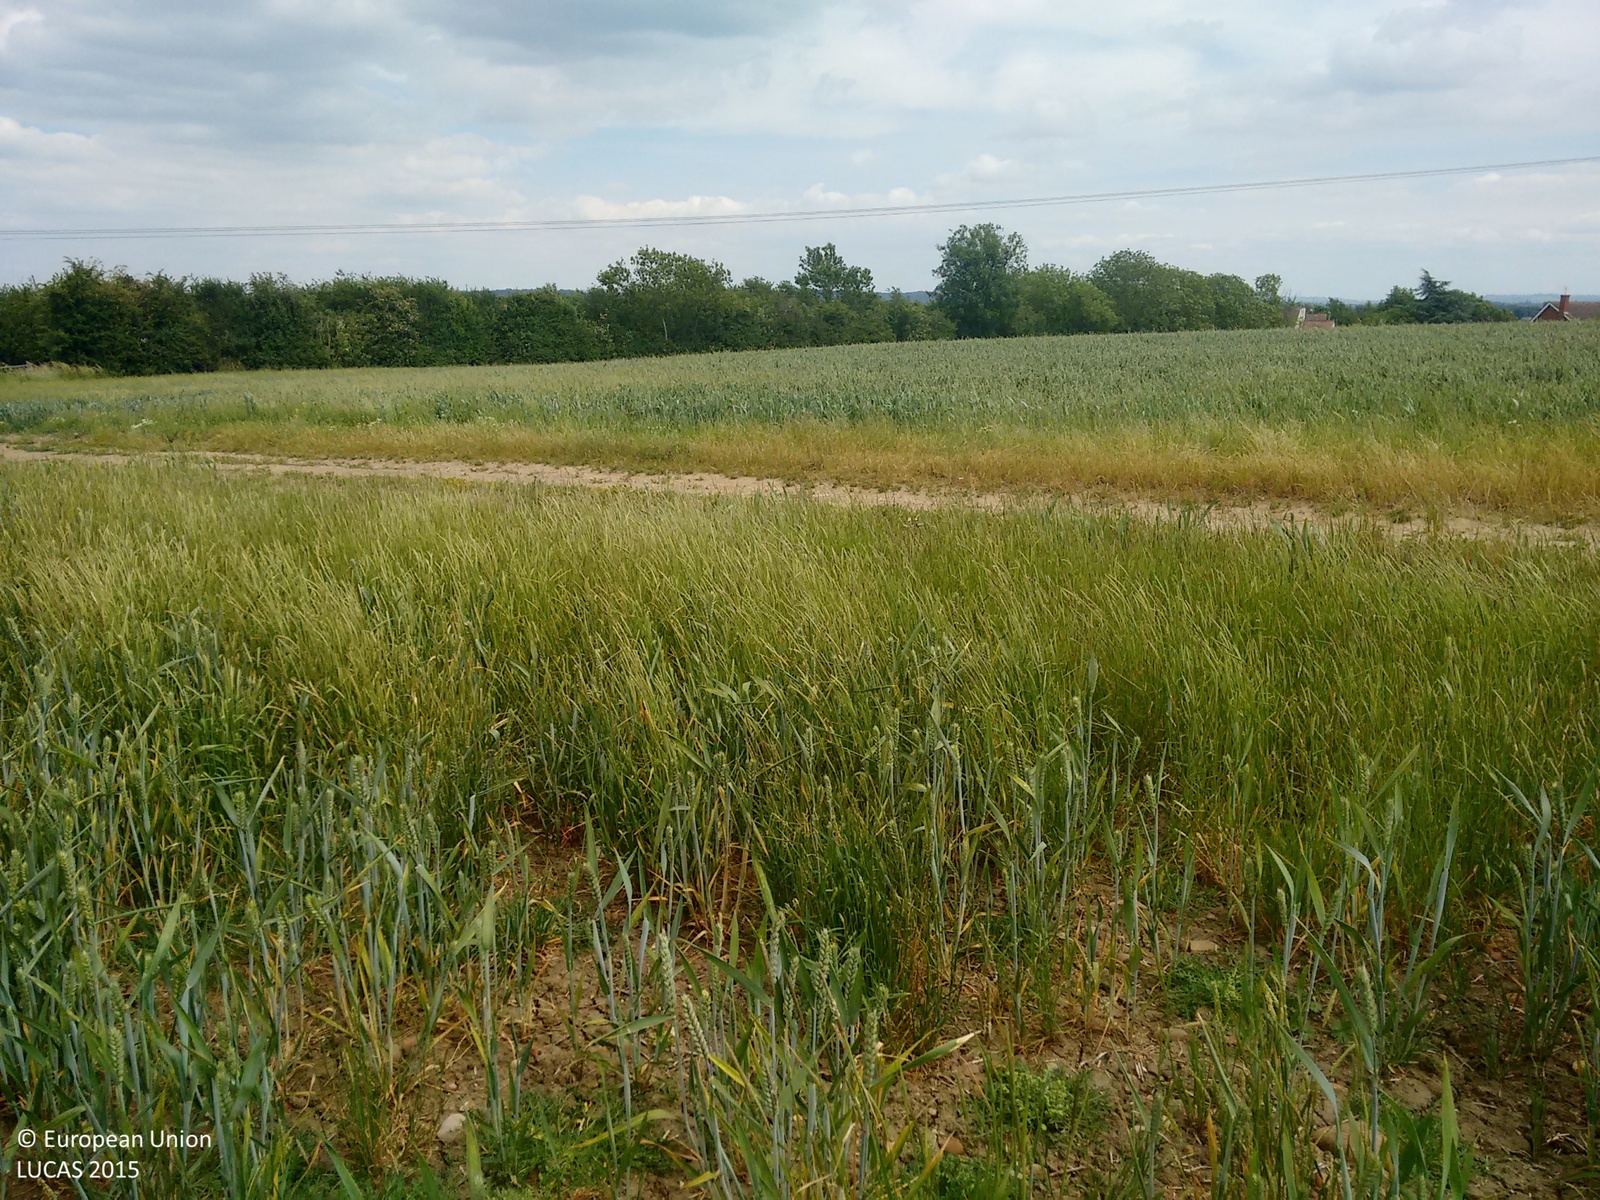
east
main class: Cropland
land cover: Common wheat
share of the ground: > 75 %
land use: Agriculture (excluding fallow land and kitchen gardens)
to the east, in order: Common wheat; Tracks; Common wheat; Electric lines; Common wheat; Grassland without tree/shrub cover; Managed hedges; Ditches and canals; Grass margins; Tracks; Grass margins; Ditches and canals; Managed hedges; Grass margins; Fences; Other bare soil
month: June
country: GB
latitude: 52.1215
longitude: -2.0800
